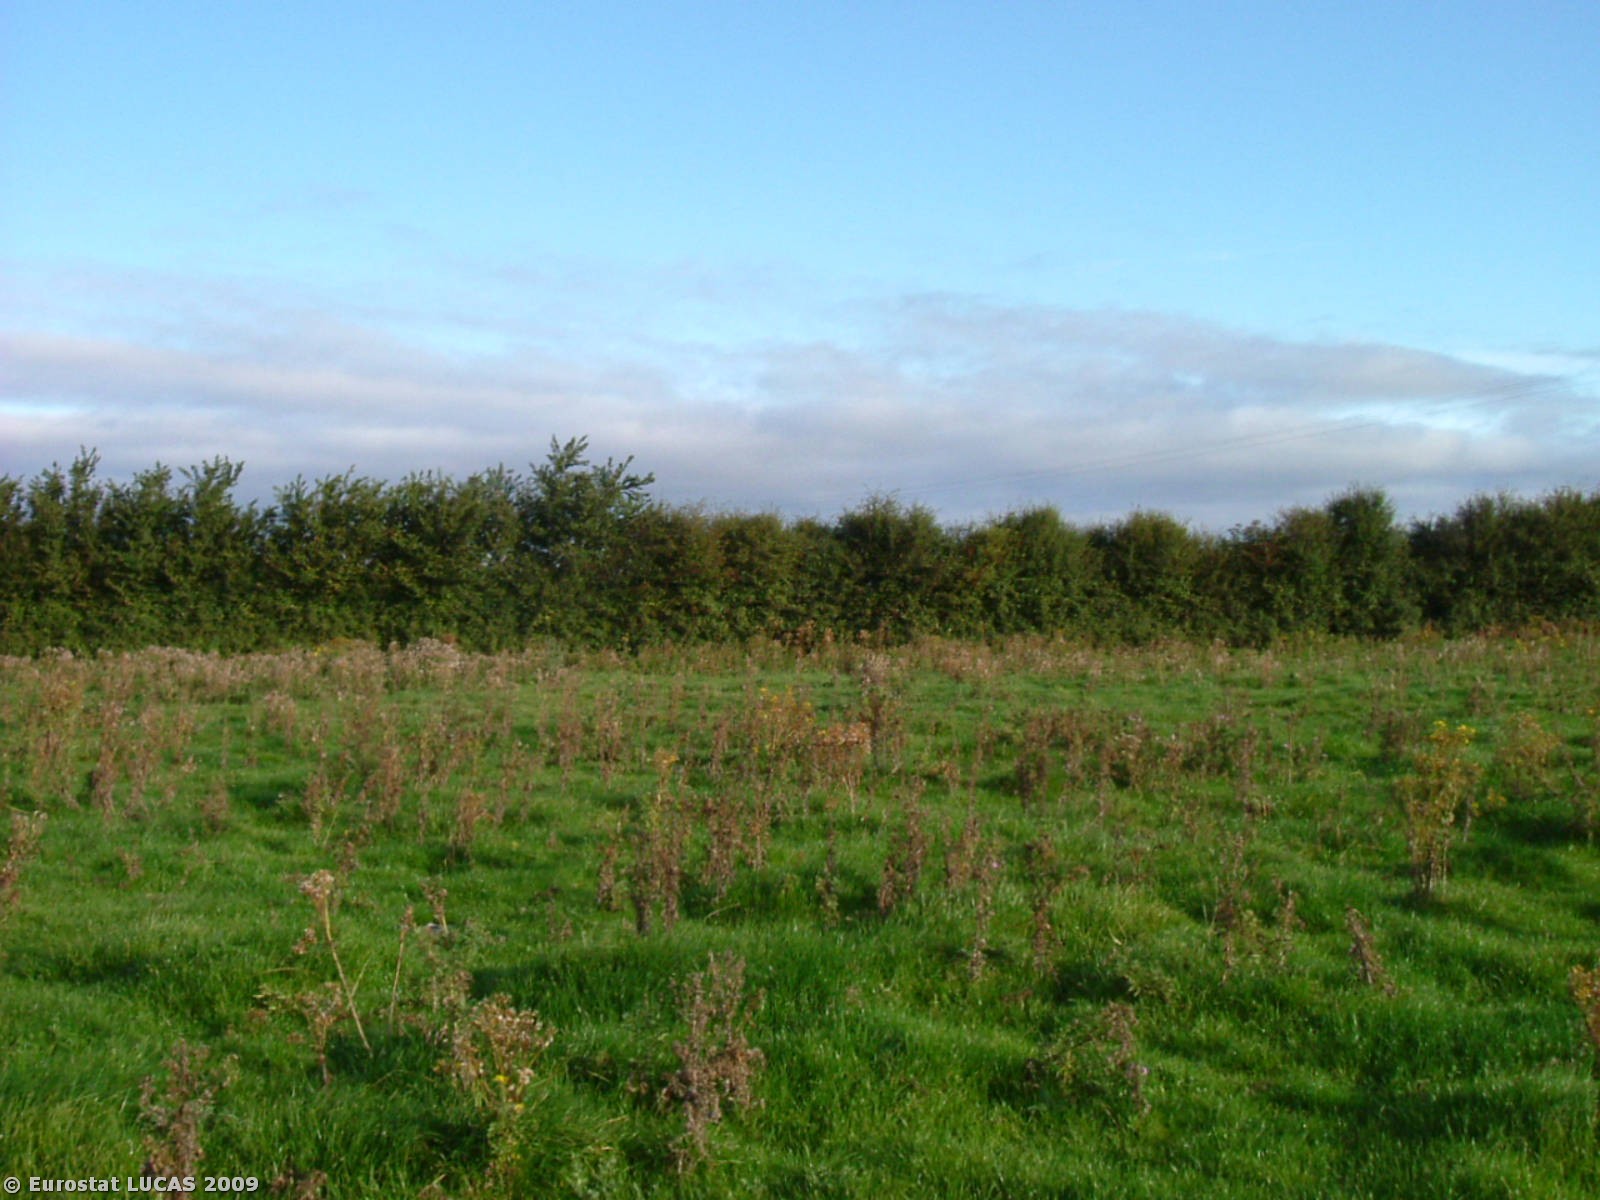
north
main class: Grassland
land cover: Grassland without tree/shrub cover
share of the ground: > 75 %
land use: Agriculture (excluding fallow land and kitchen gardens)
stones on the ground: < 10 %
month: October
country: IE
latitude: 52.6477
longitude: -7.7409
